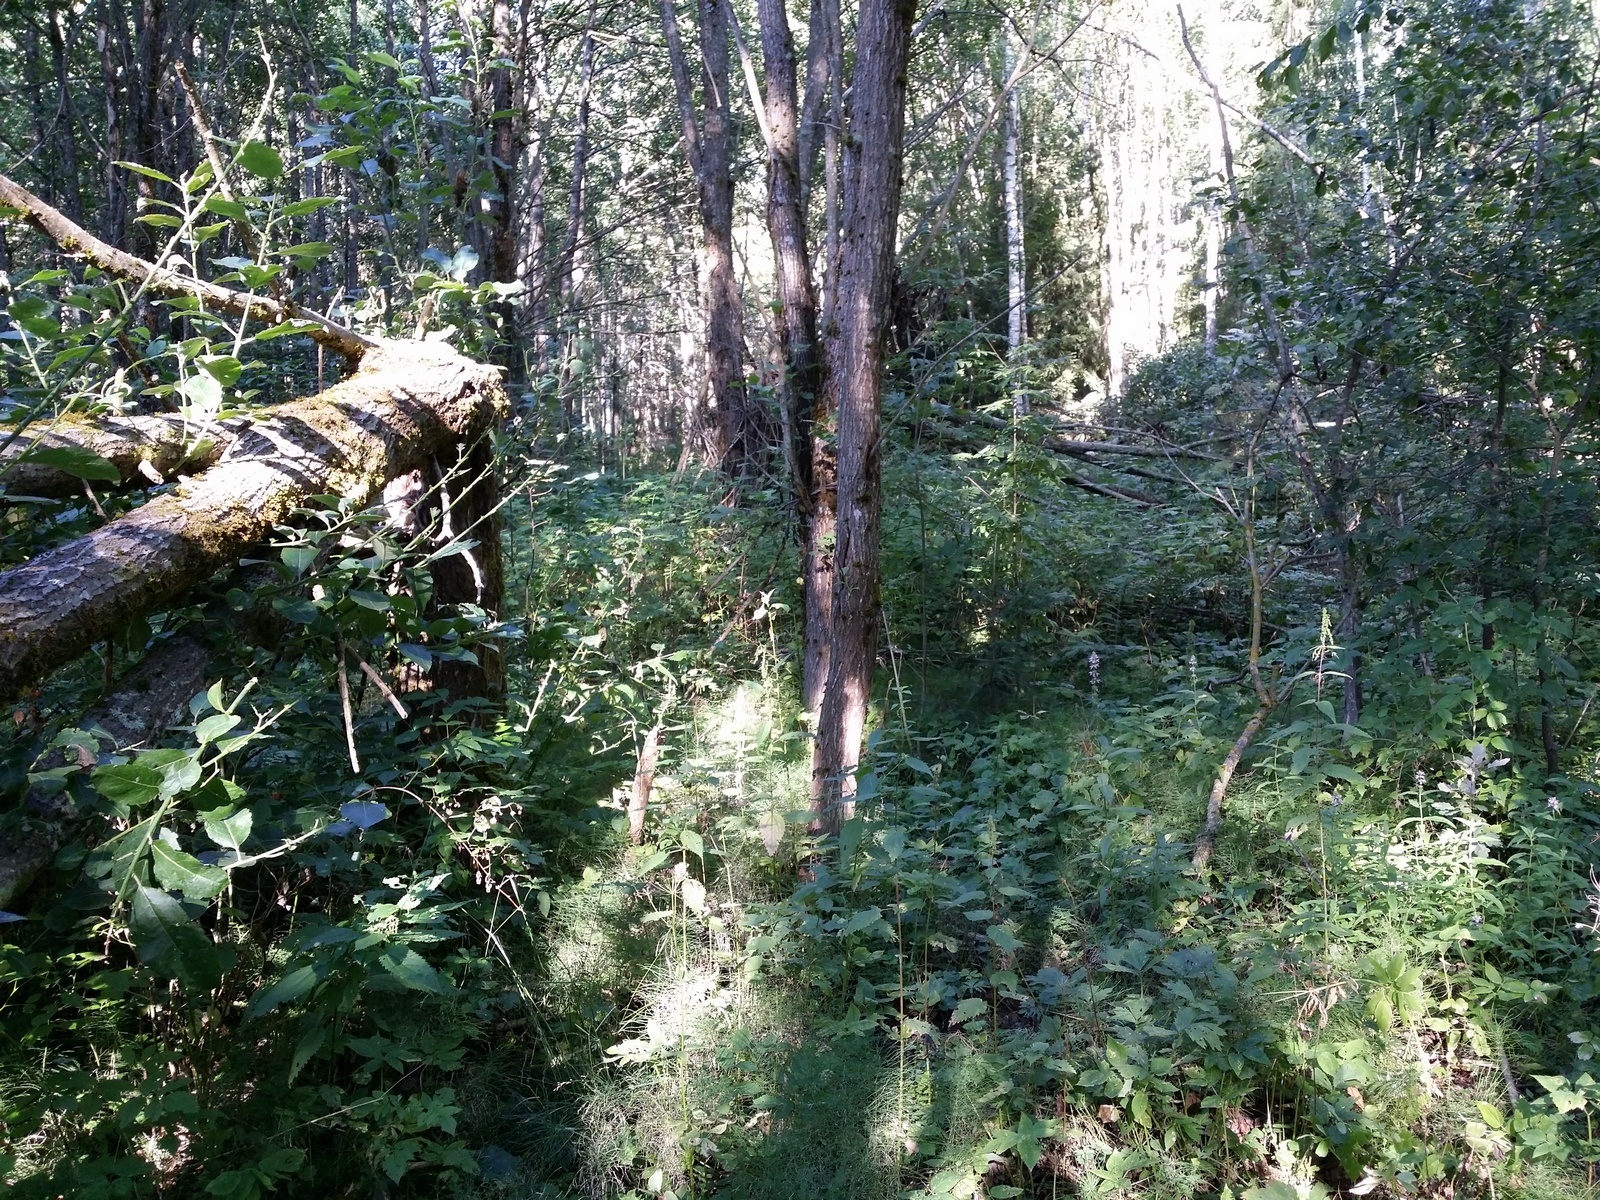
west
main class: Woodland
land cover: Broadleaved woodland
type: non-riverine alder, birch or aspen forest
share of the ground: > 75 %
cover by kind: broadleaved forest trees 75 %, shrubs 20 %, coniferous forest trees 5 %
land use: Forestry
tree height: > 5 m
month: August
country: LV
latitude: 56.9084
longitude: 27.6388
